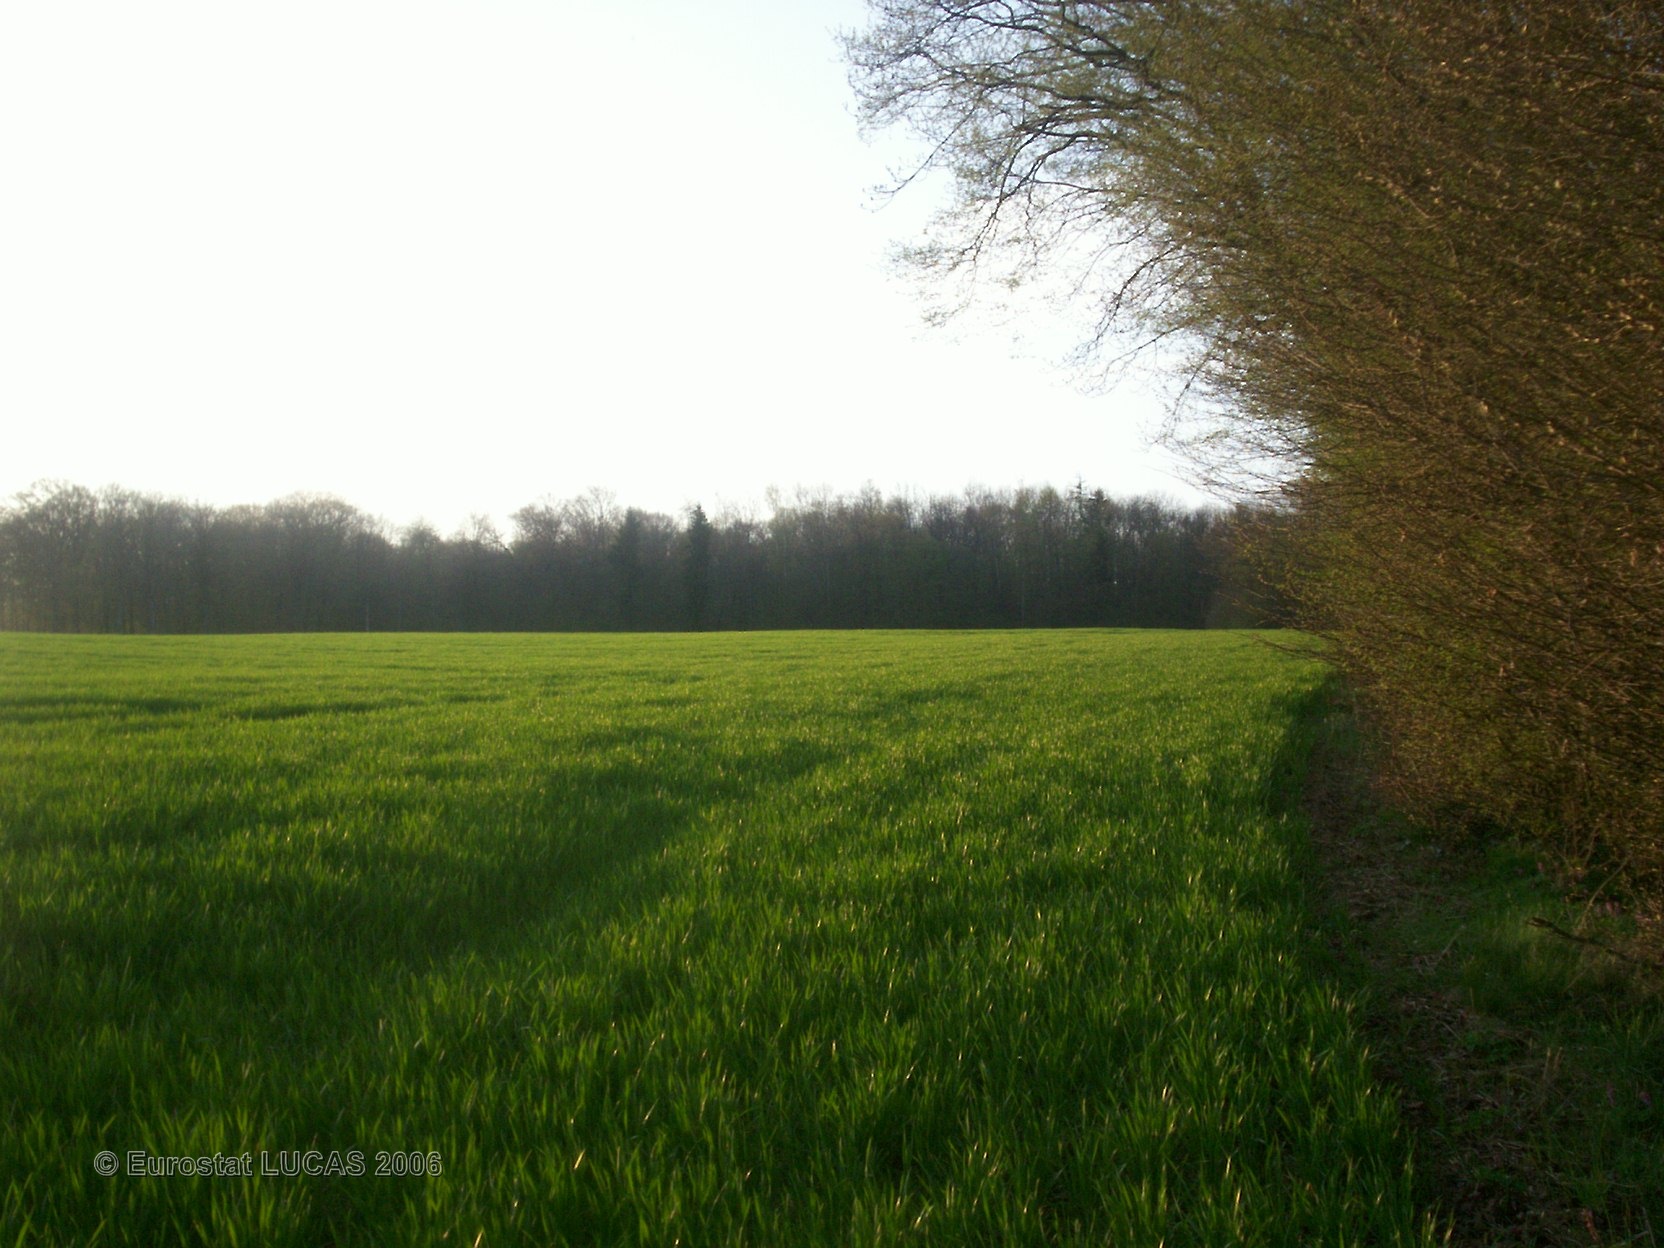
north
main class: Cropland
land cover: Barley
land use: Agriculture (excluding fallow land and kitchen gardens)
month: April
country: FR
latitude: 47.4768
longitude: 6.2994
